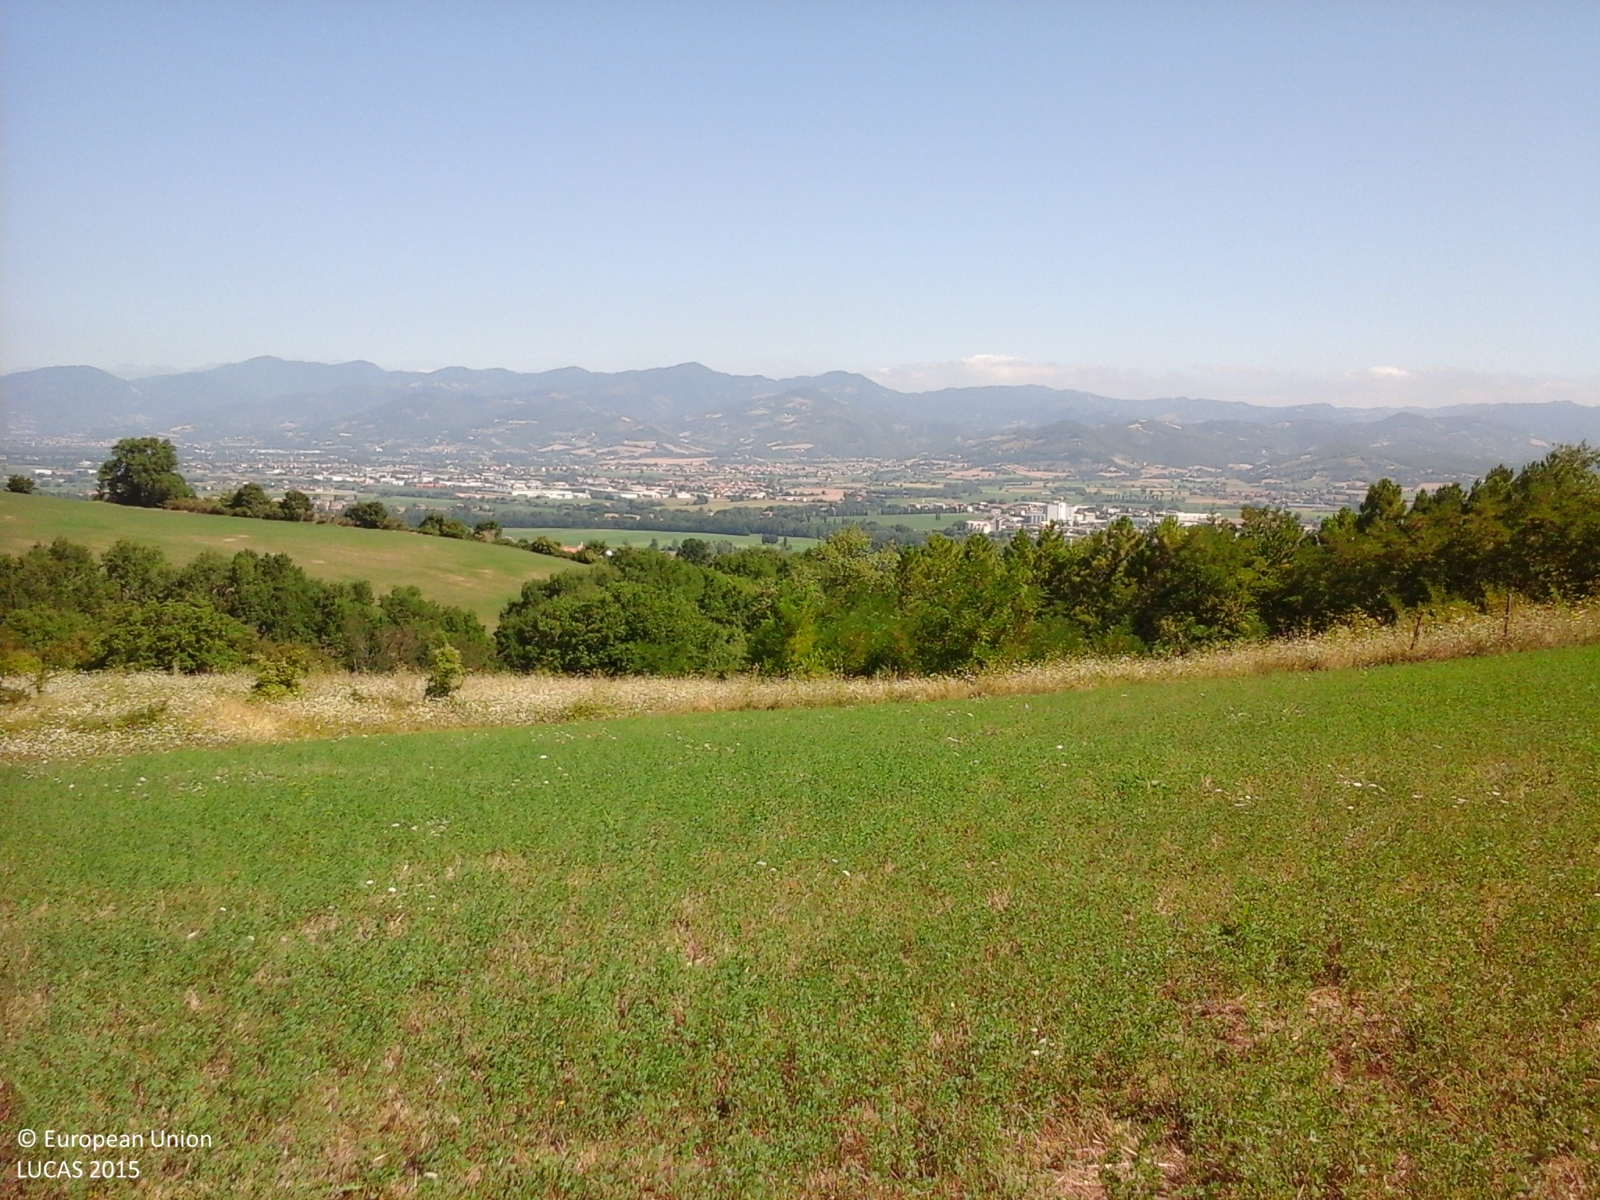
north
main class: Cropland
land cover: Lucerne
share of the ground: > 75 %
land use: Agriculture (excluding fallow land and kitchen gardens)
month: August
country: IT
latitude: 43.4608
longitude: 12.2064
